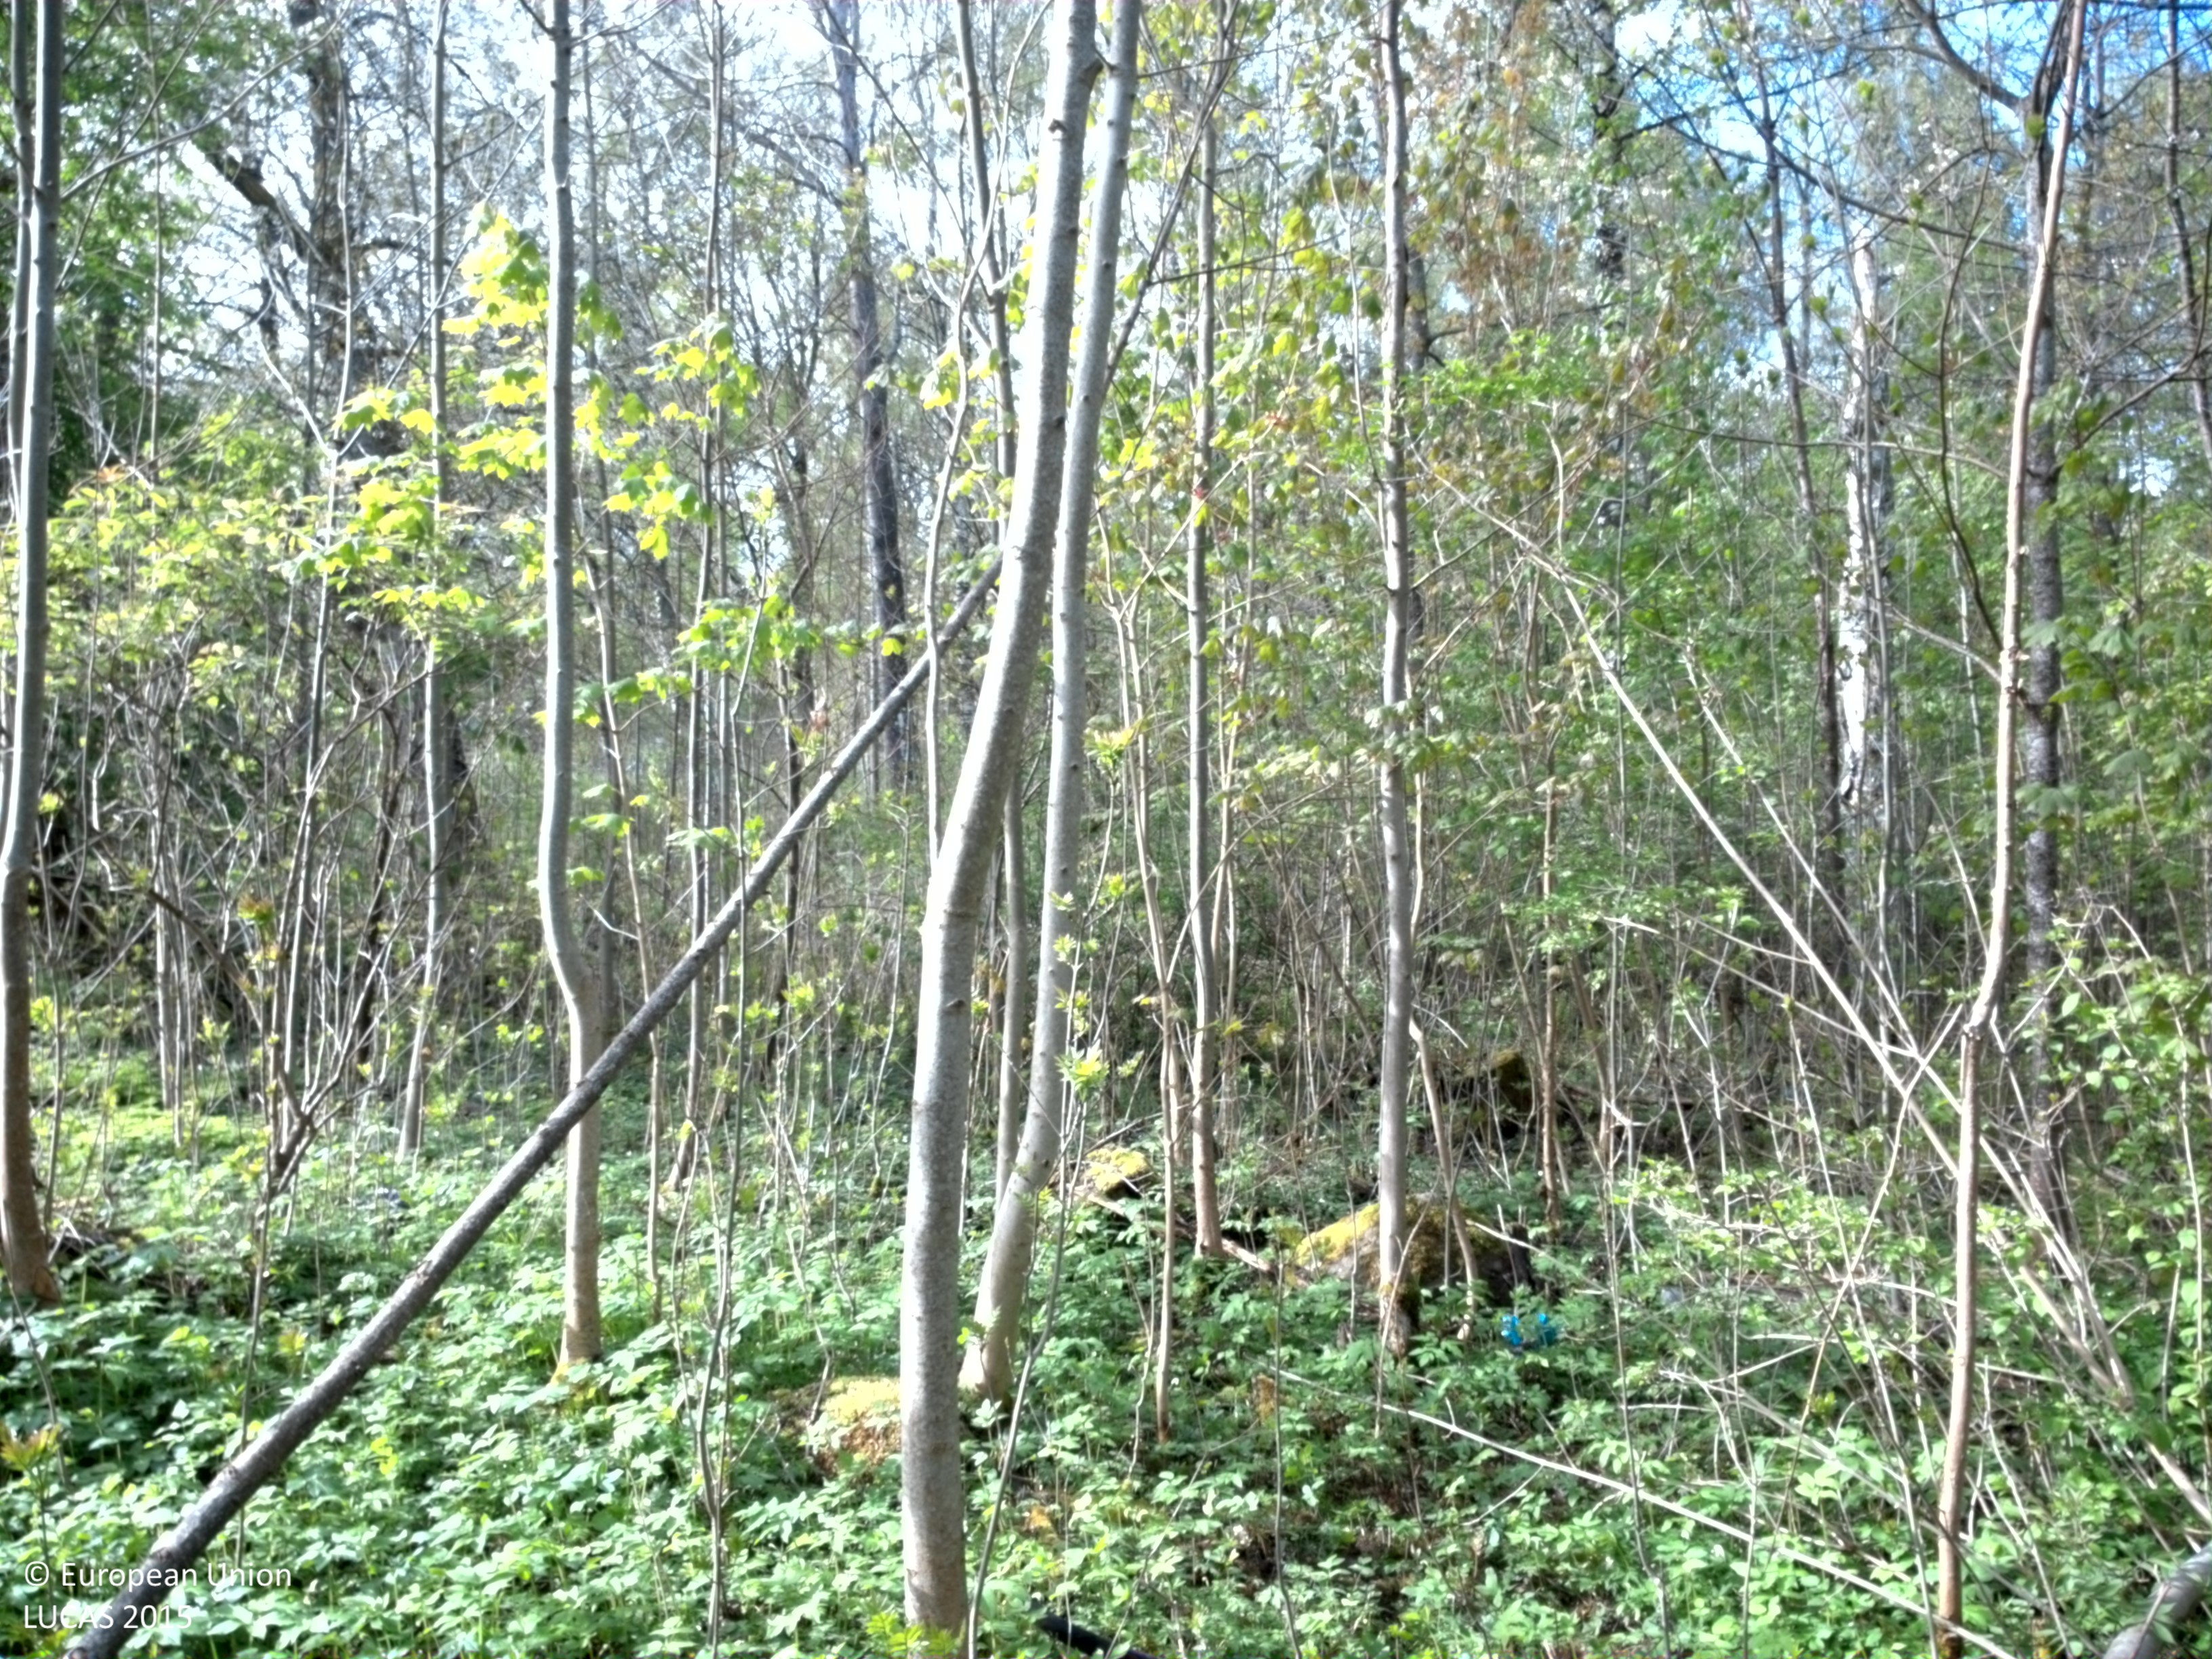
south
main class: Woodland
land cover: Broadleaved woodland
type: boreal forest
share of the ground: 50 - 75 %
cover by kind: broadleaved forest trees 60 %, herbaceous plants 20 %, lichens and mosses 20 %
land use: Amenities, museums, leisure
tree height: > 5 m
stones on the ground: < 10 %
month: May
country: SE
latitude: 56.8545
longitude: 14.8020
